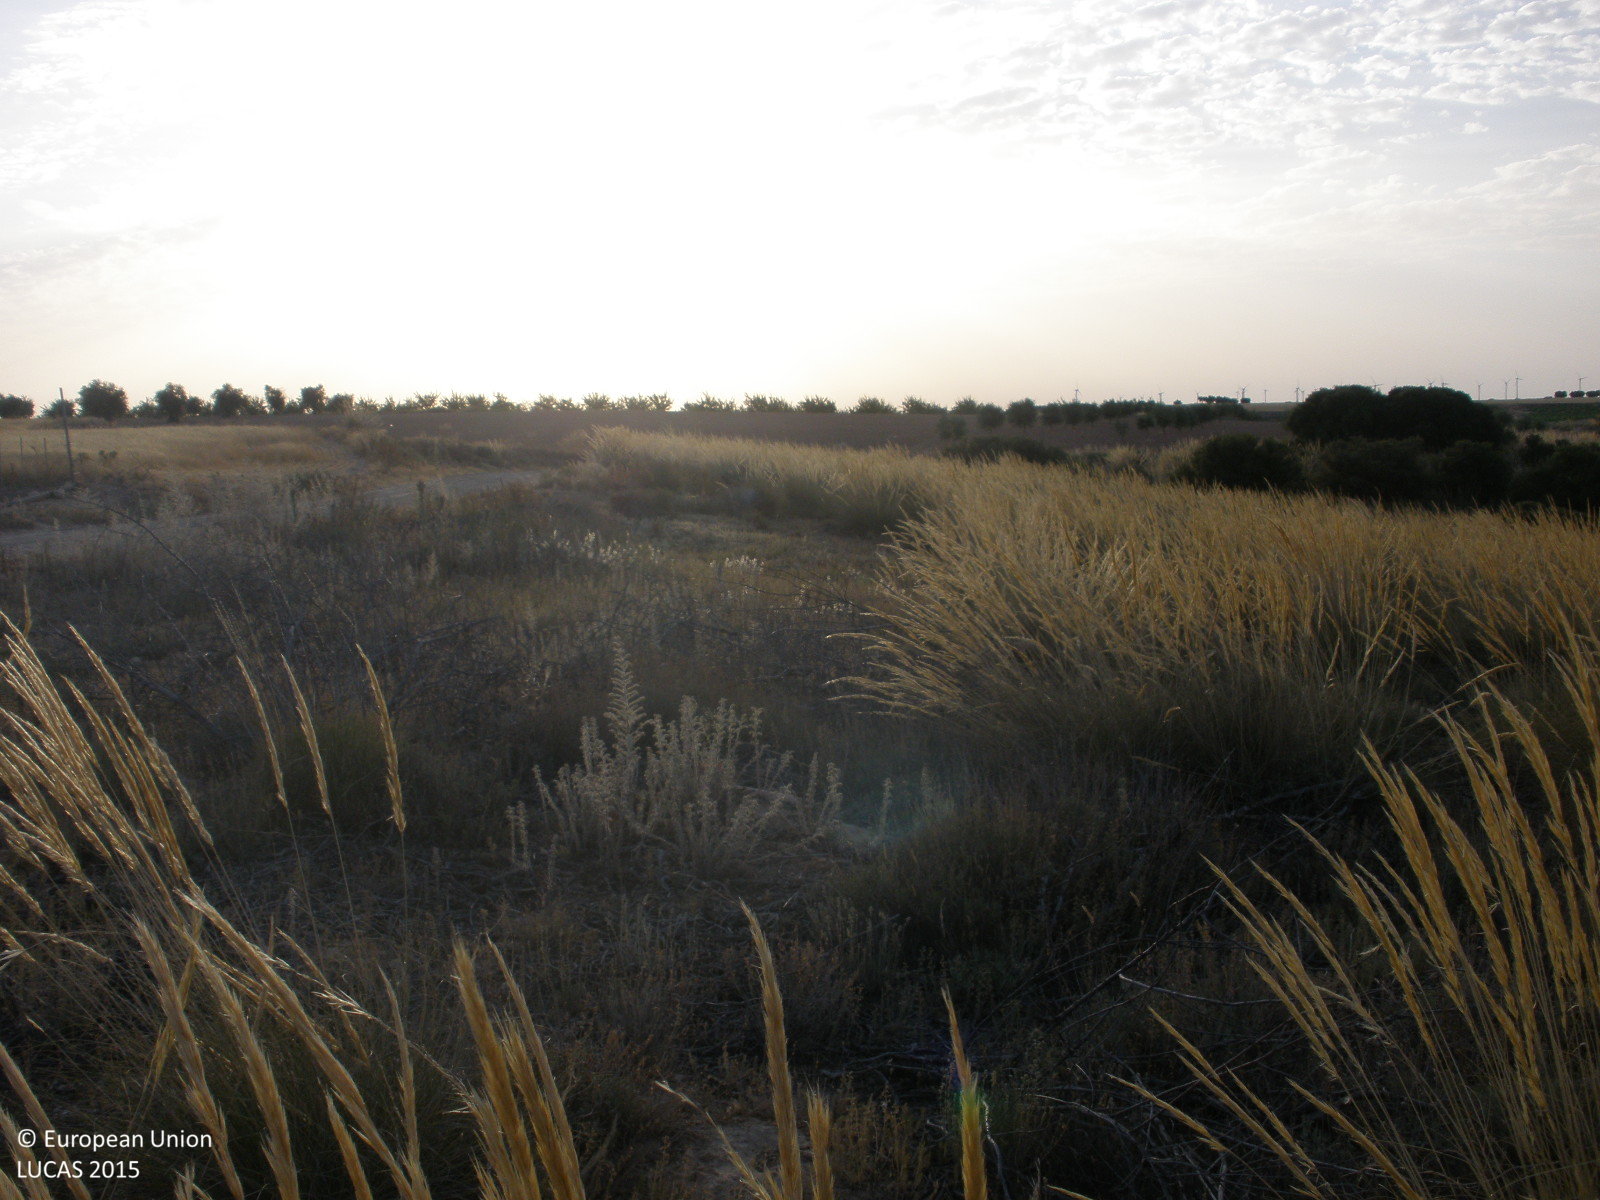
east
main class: Shrubland
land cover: Shrubland without tree cover
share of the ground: 25 - 50 %
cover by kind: herbaceous plants 50 %, shrubs 40 %, consolidated bare surface 10 %
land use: Semi-natural and natural areas not in use
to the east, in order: Shrubland without tree cover; Broadleaved woodland; Tracks; Grass margins; Olive groves; Shrubland without tree cover; Tracks
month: July
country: ES
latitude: 40.0004
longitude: -3.4168
